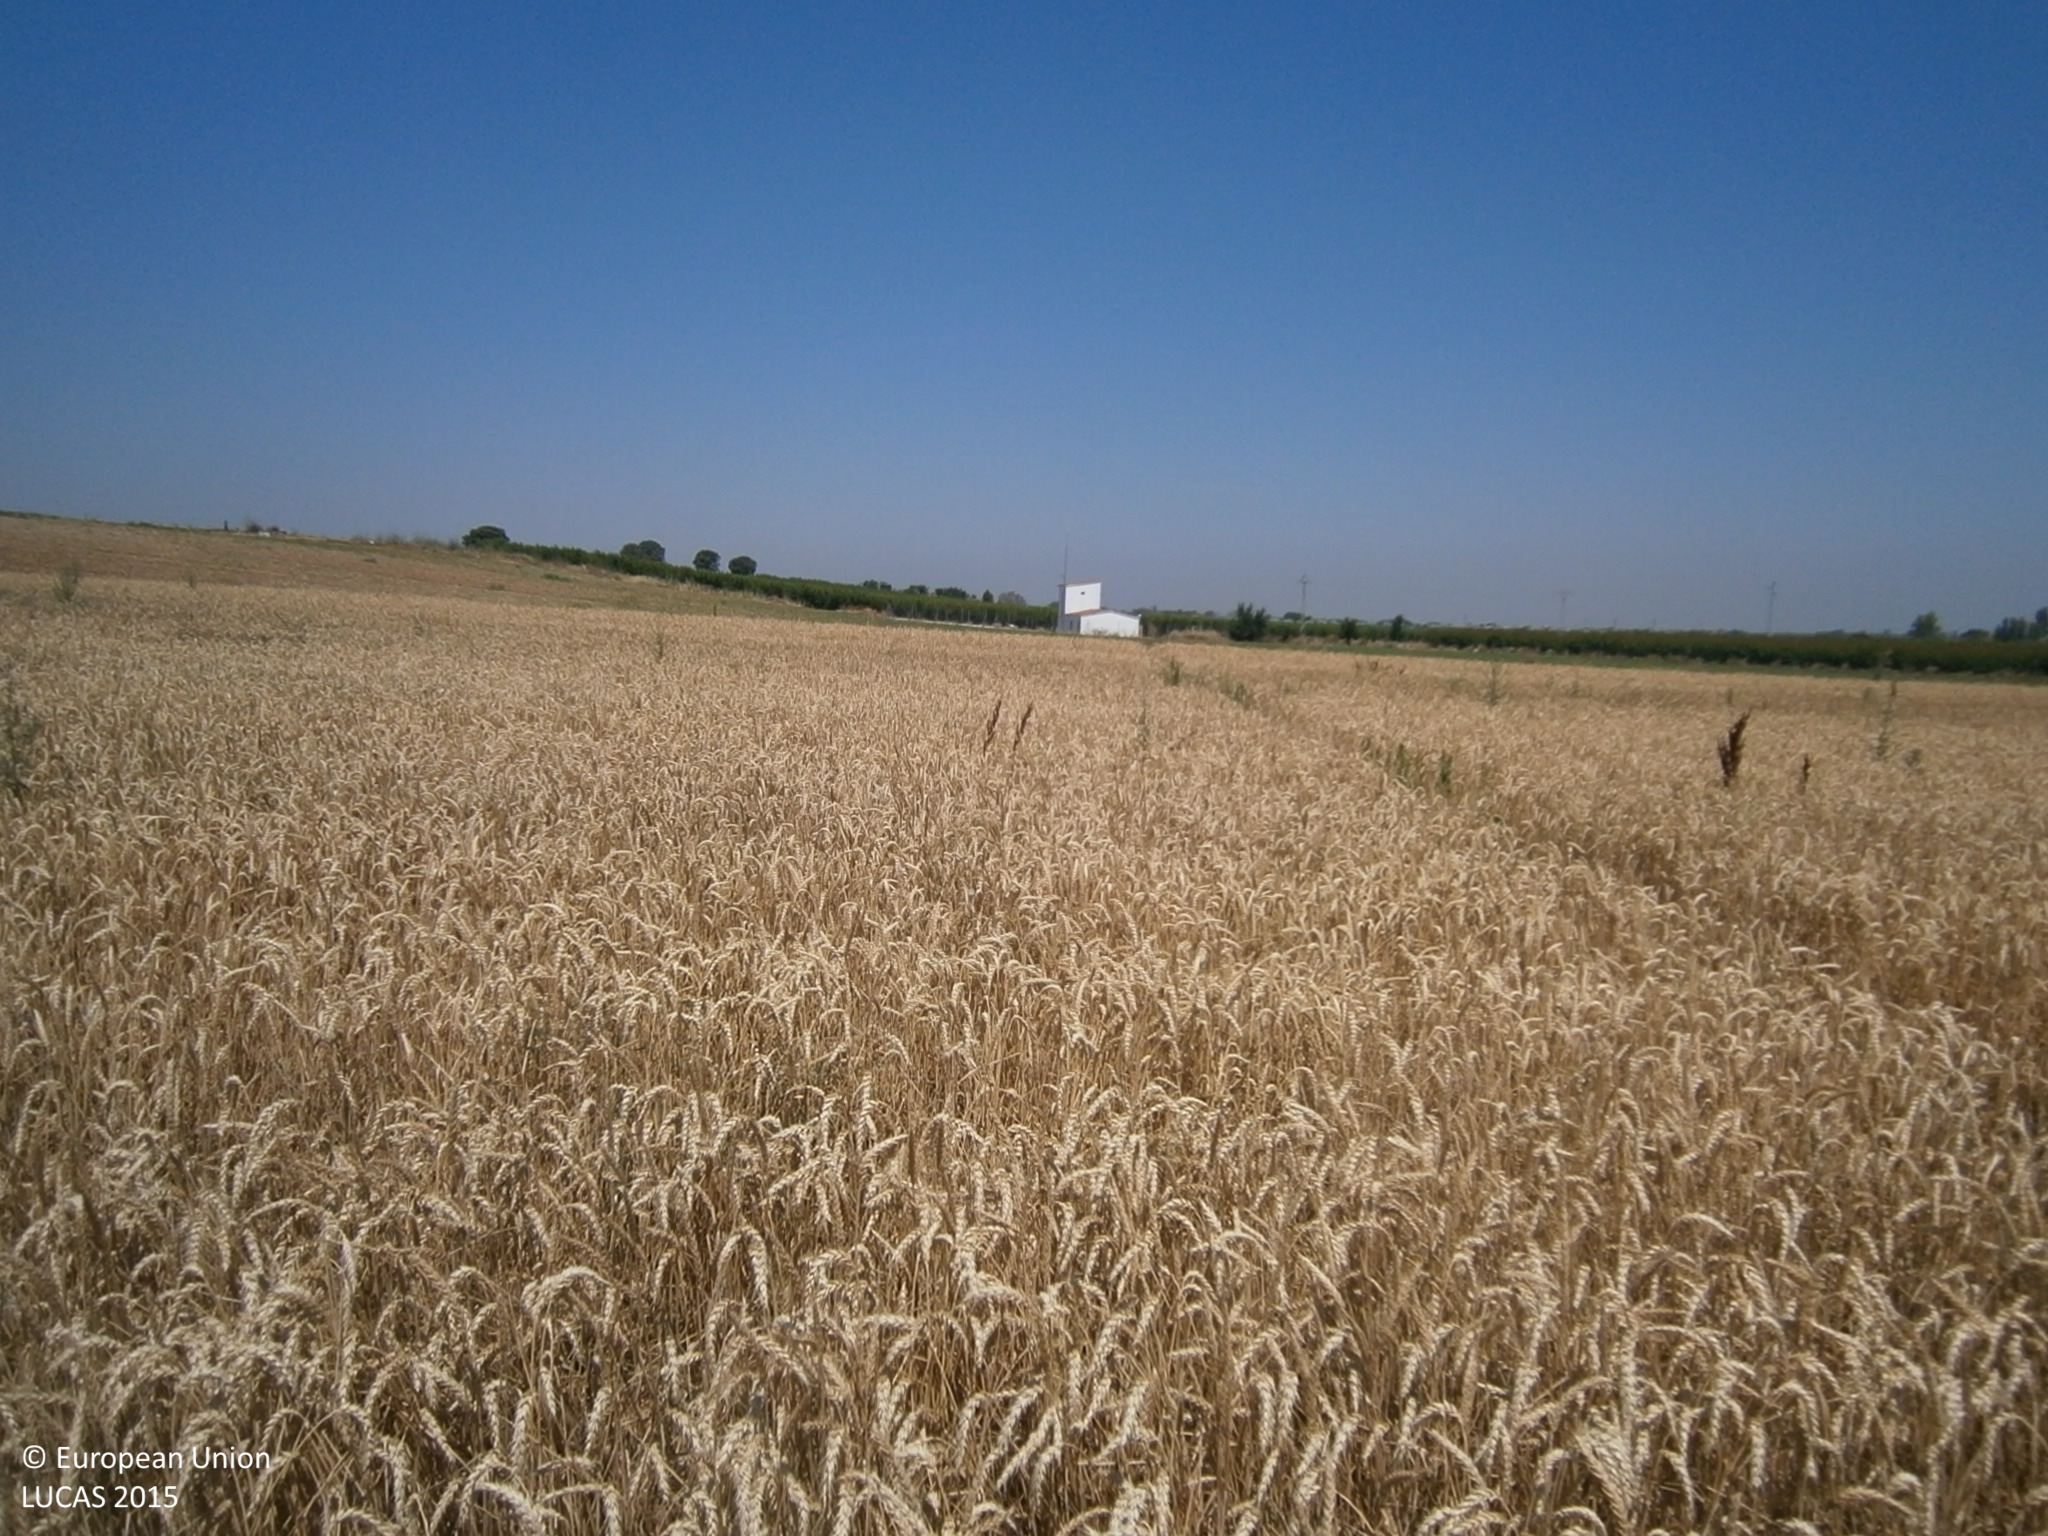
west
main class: Cropland
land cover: Barley
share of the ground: > 75 %
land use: Agriculture (excluding fallow land and kitchen gardens)
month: June
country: ES
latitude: 38.8449
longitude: -6.6889
